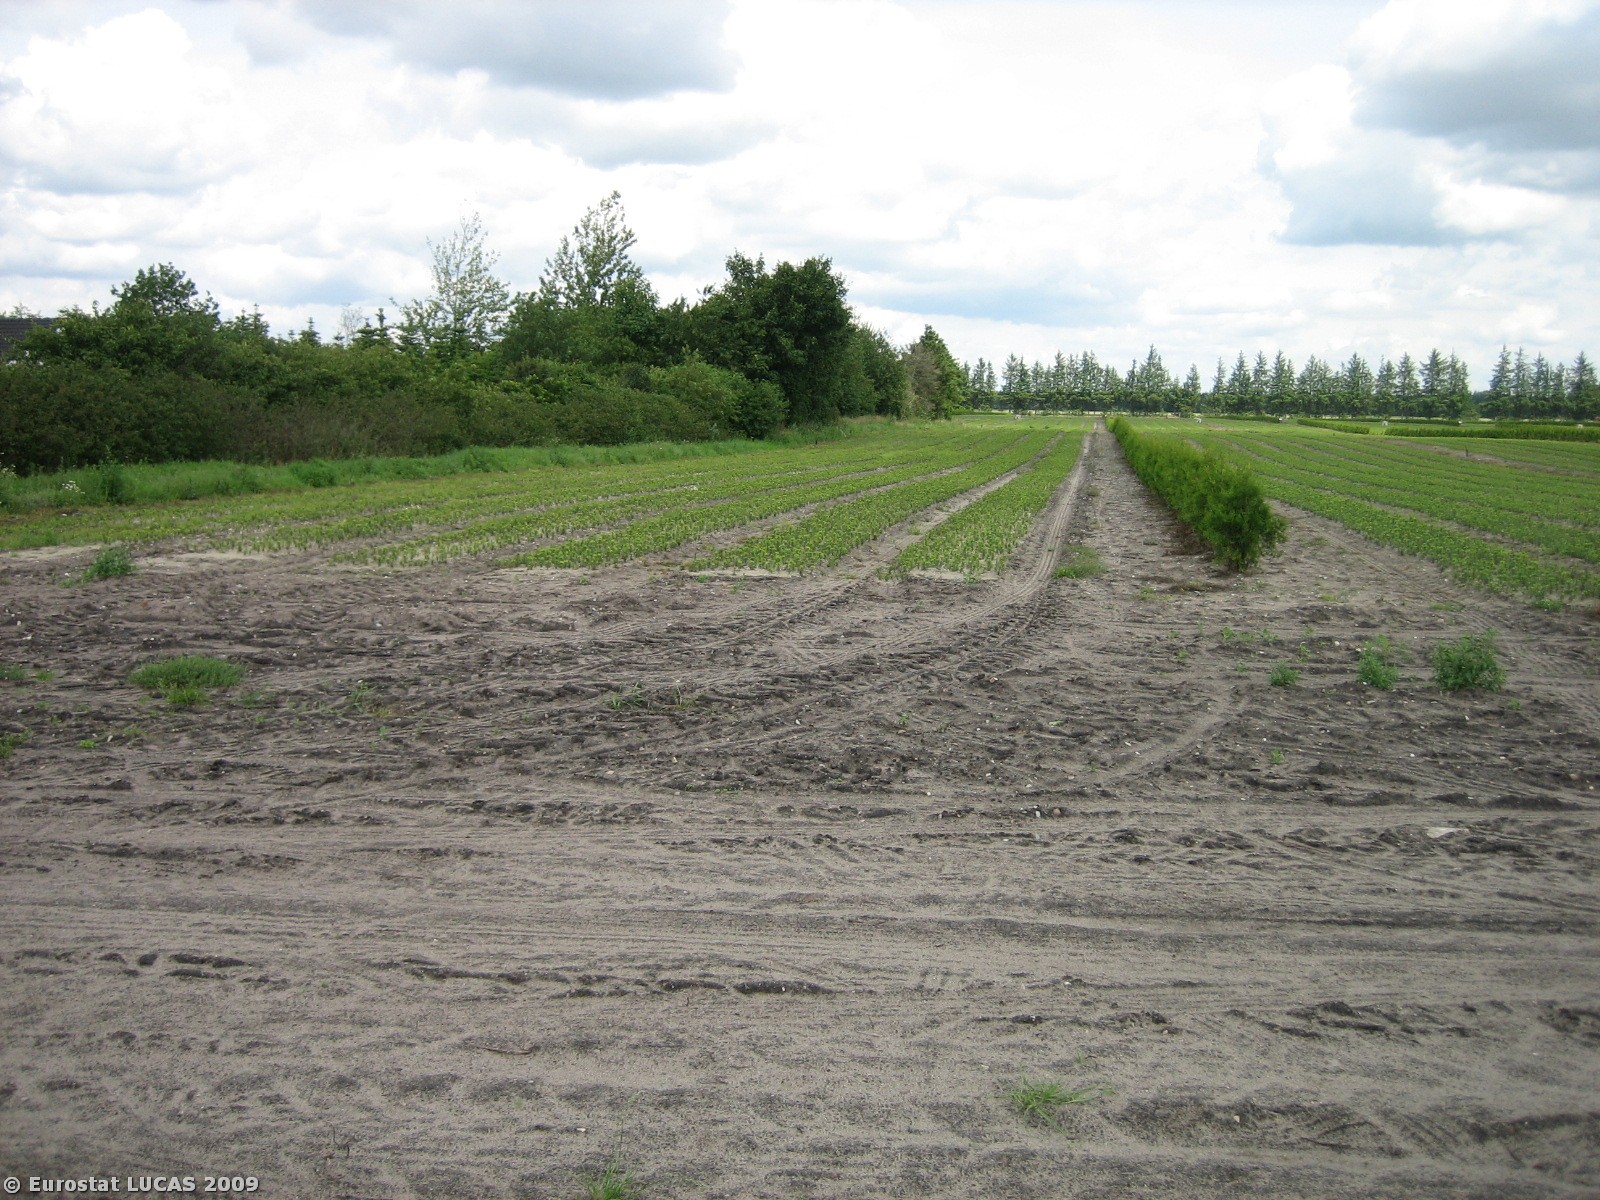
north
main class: Cropland
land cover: Nurseries
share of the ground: 50 - 75 %
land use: Agriculture (excluding fallow land and kitchen gardens)
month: July
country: DK
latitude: 55.8058
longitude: 8.9321
